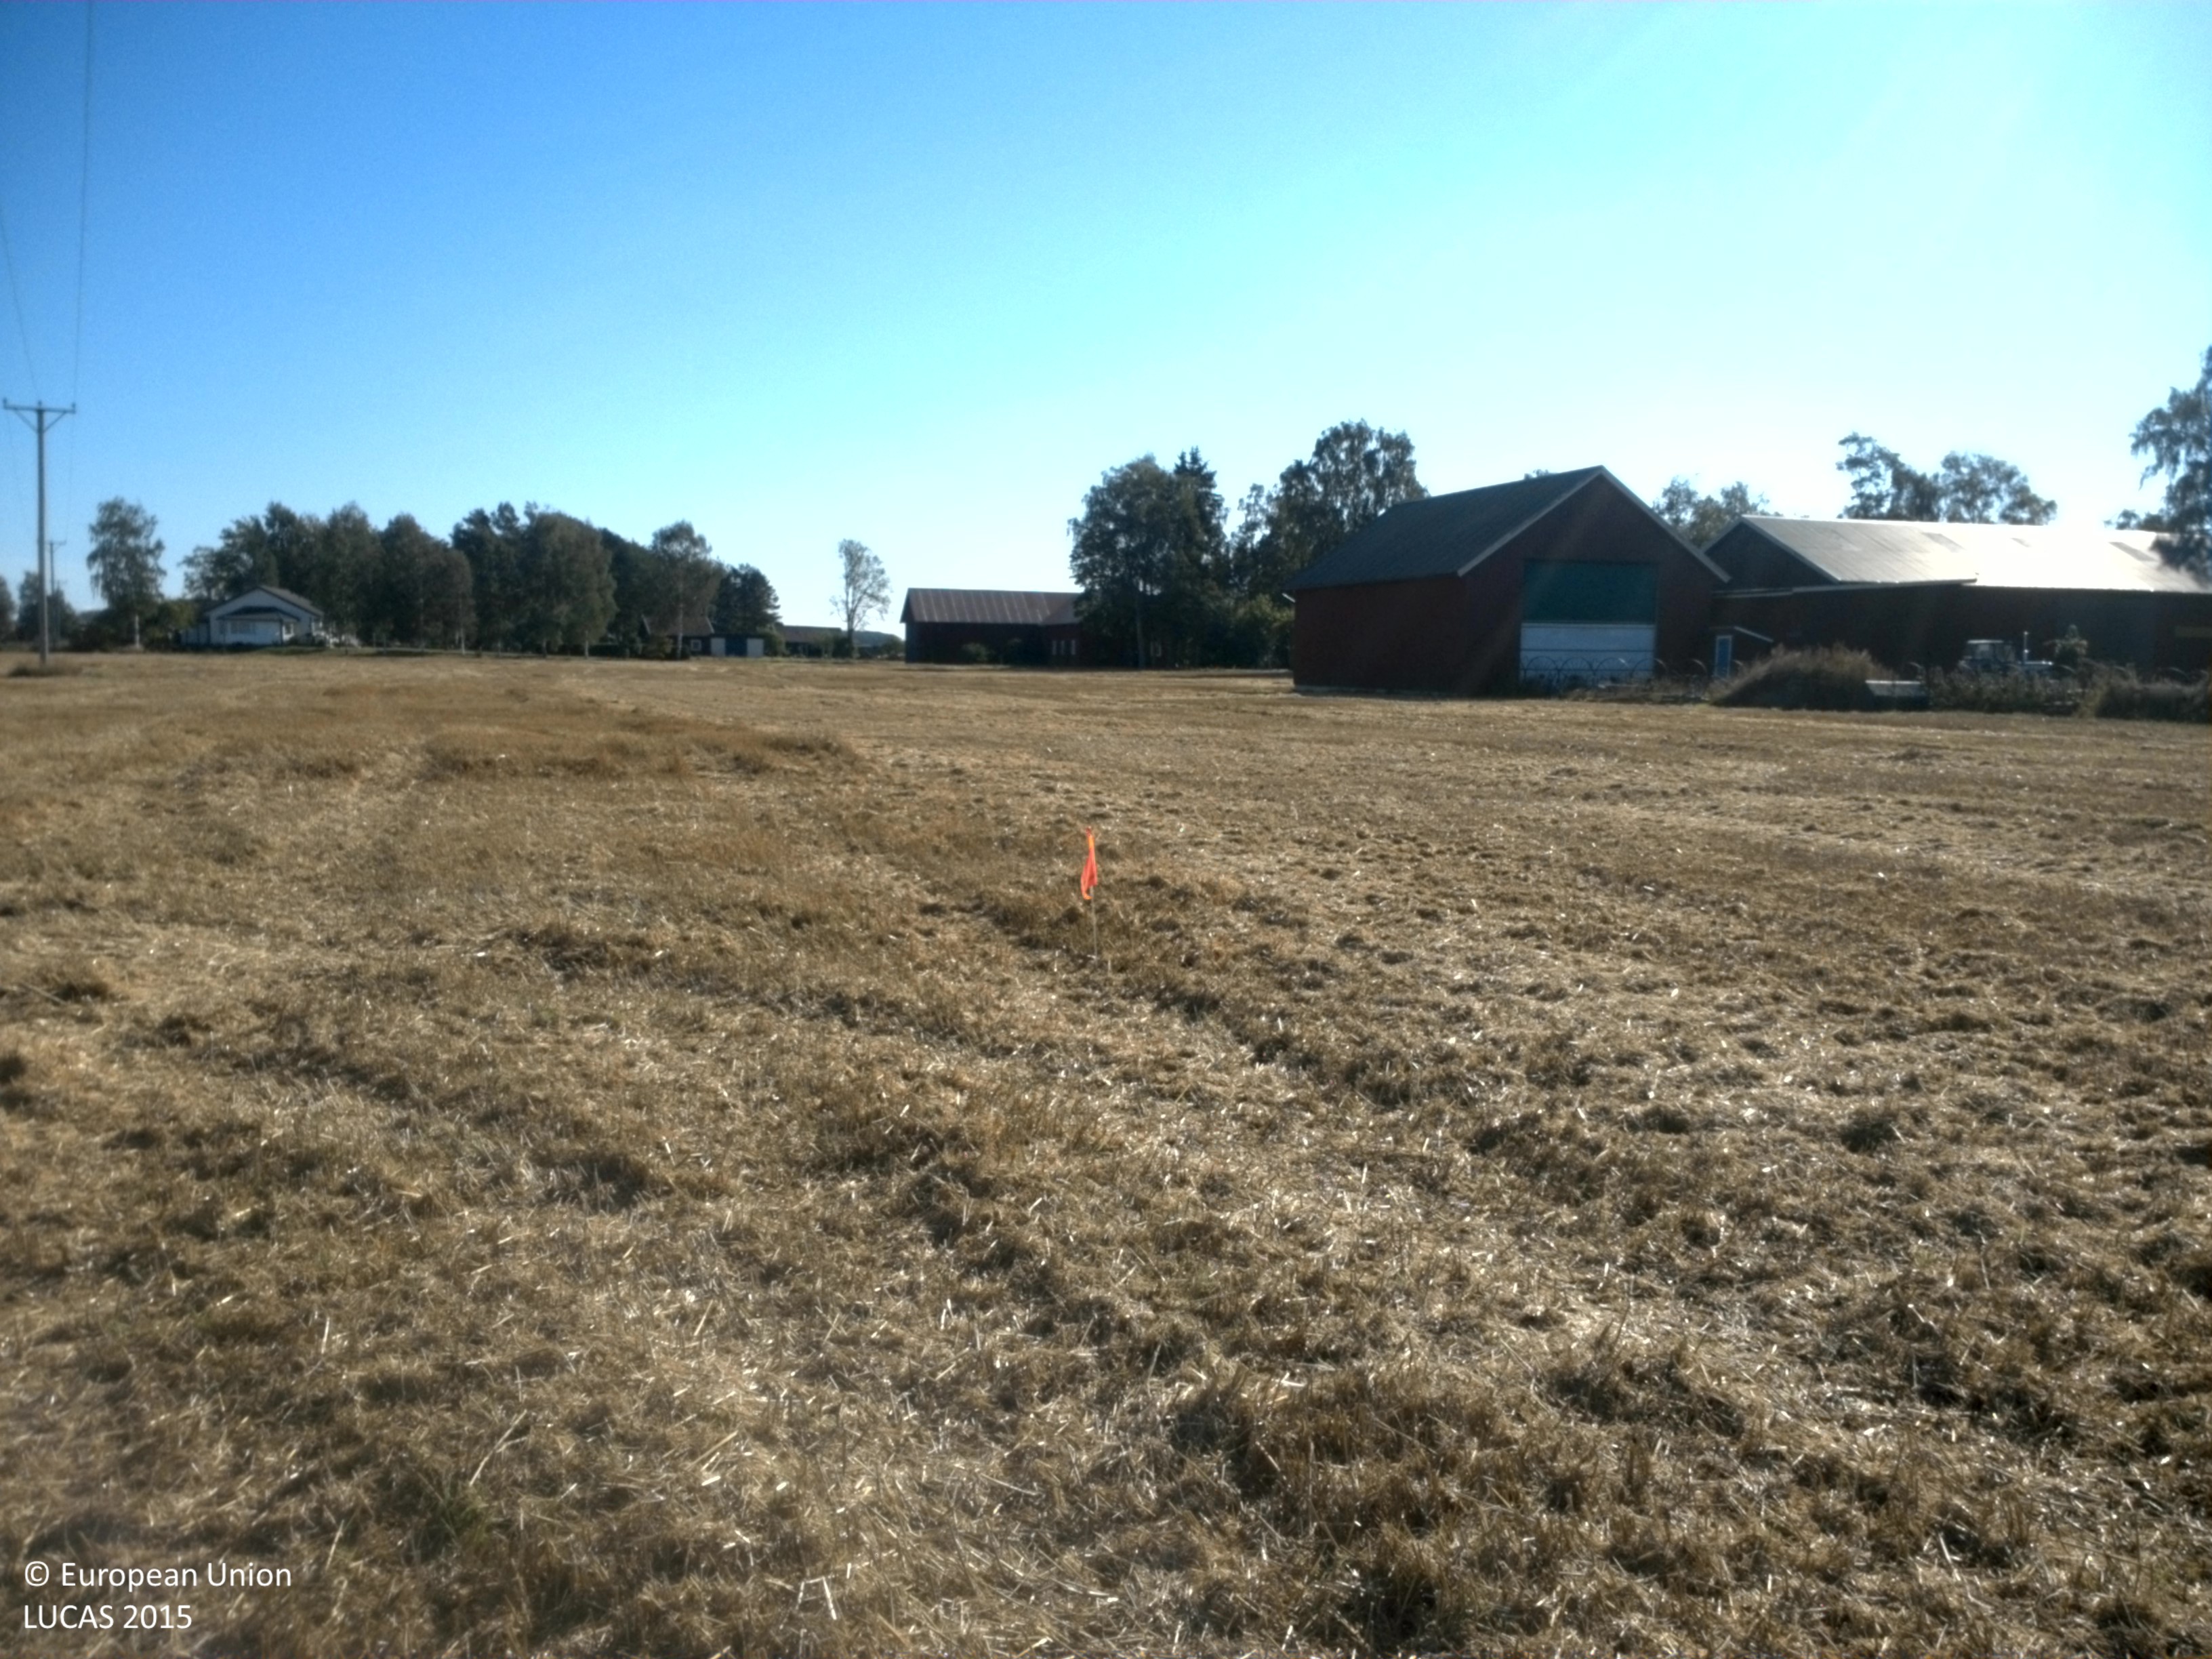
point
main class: Cropland
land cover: Common wheat
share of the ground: 50 - 75 %
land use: Agriculture (excluding fallow land and kitchen gardens)
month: September
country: SE
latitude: 58.3968
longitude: 13.2279
